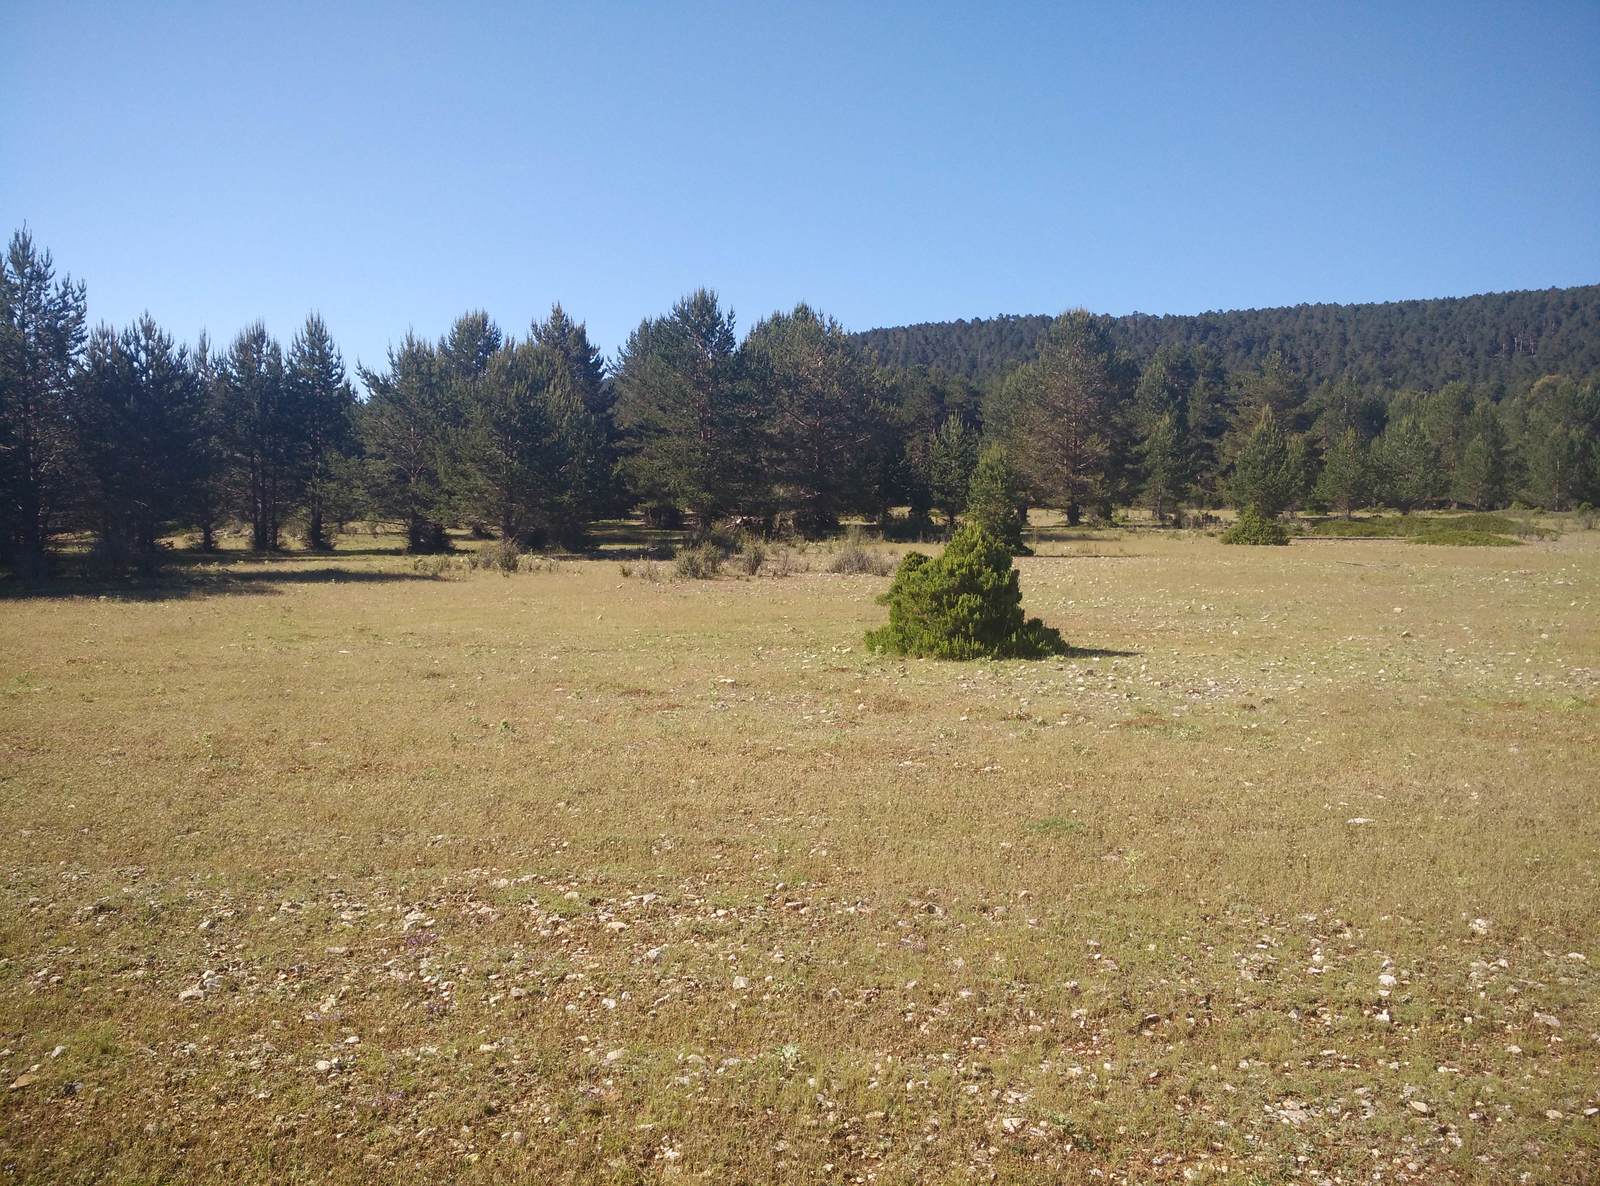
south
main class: Grassland
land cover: Grassland without tree/shrub cover
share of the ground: 50 - 75 %
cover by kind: herbaceous plants 70 %, consolidated bare surface 25 %, unconsolidated bare surface 5 %
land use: Agriculture (excluding fallow land and kitchen gardens)
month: June
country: ES
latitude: 40.3821
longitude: -1.7361
